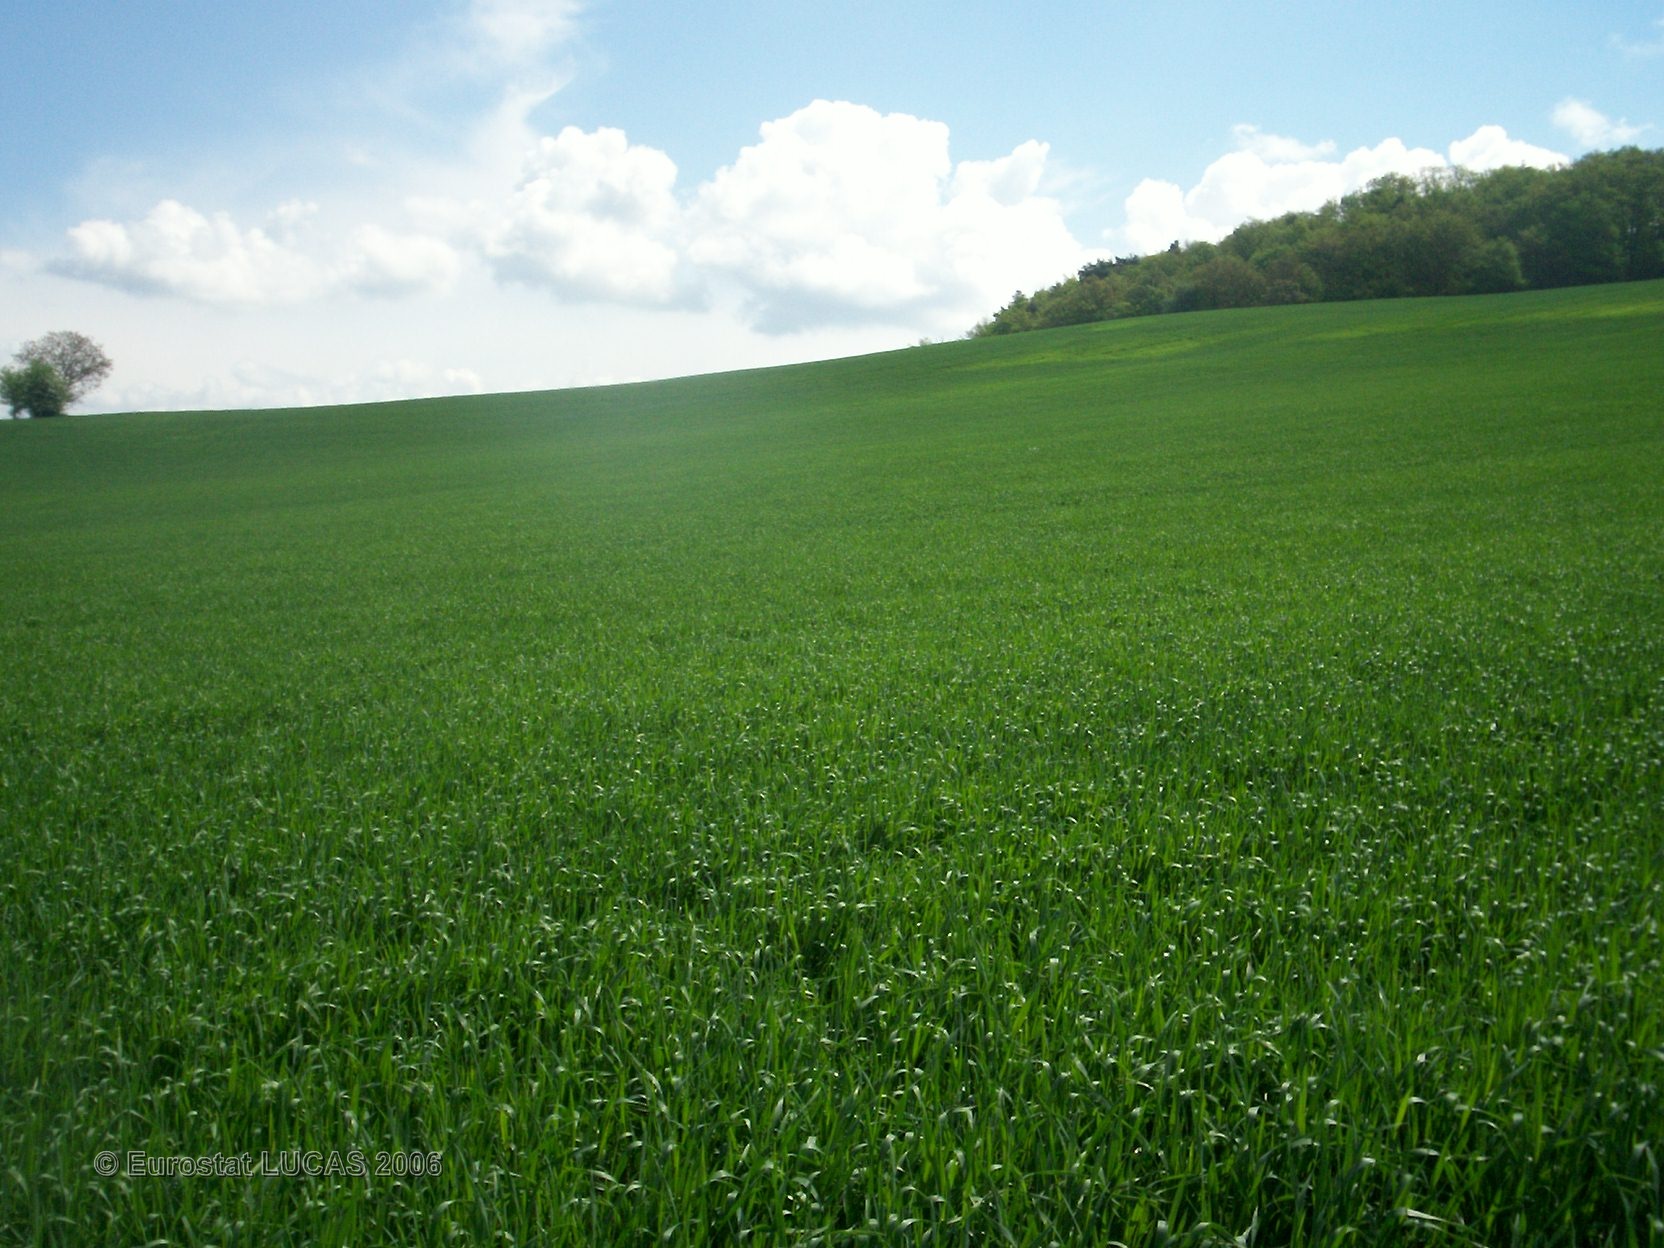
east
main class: Cropland
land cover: Common wheat
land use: Agriculture (excluding fallow land and kitchen gardens)
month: May
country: FR
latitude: 45.5757
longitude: 3.2217
